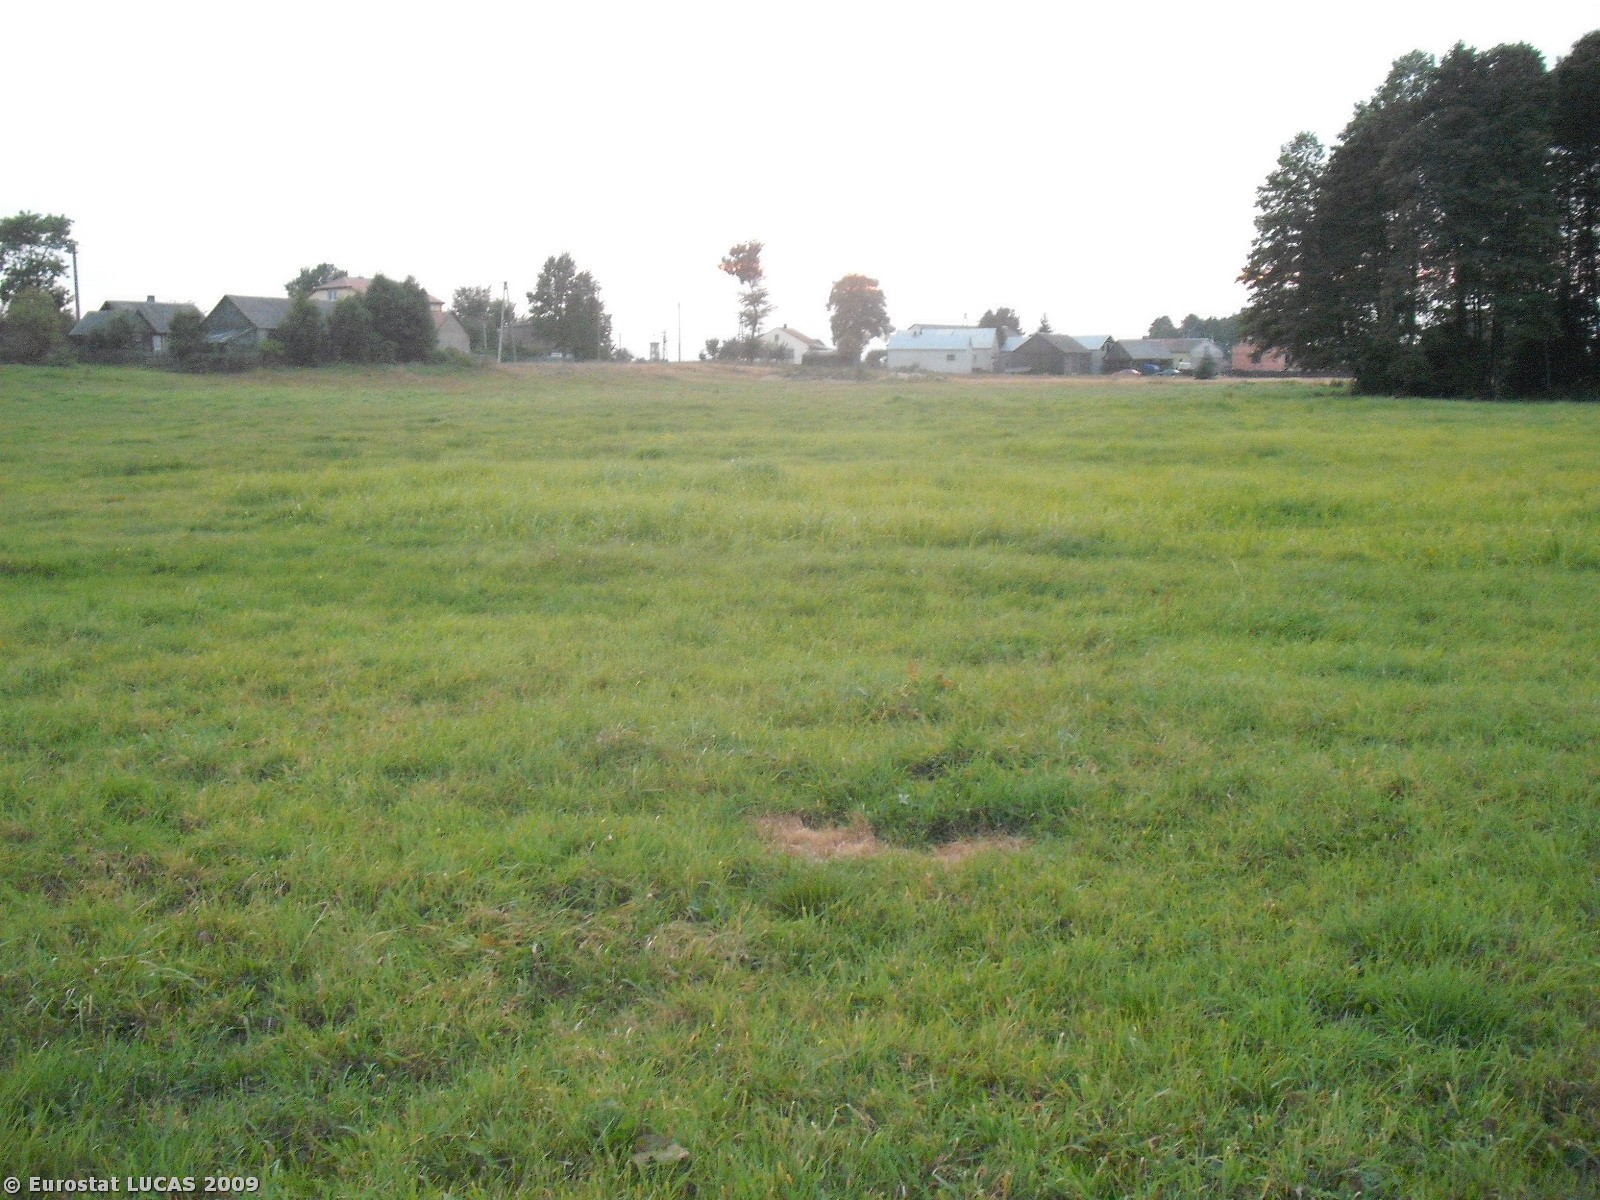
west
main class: Grassland
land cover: Grassland without tree/shrub cover
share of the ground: > 75 %
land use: Agriculture (excluding fallow land and kitchen gardens)
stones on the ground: < 10 %
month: September
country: PL
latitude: 51.7883
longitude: 22.1369
